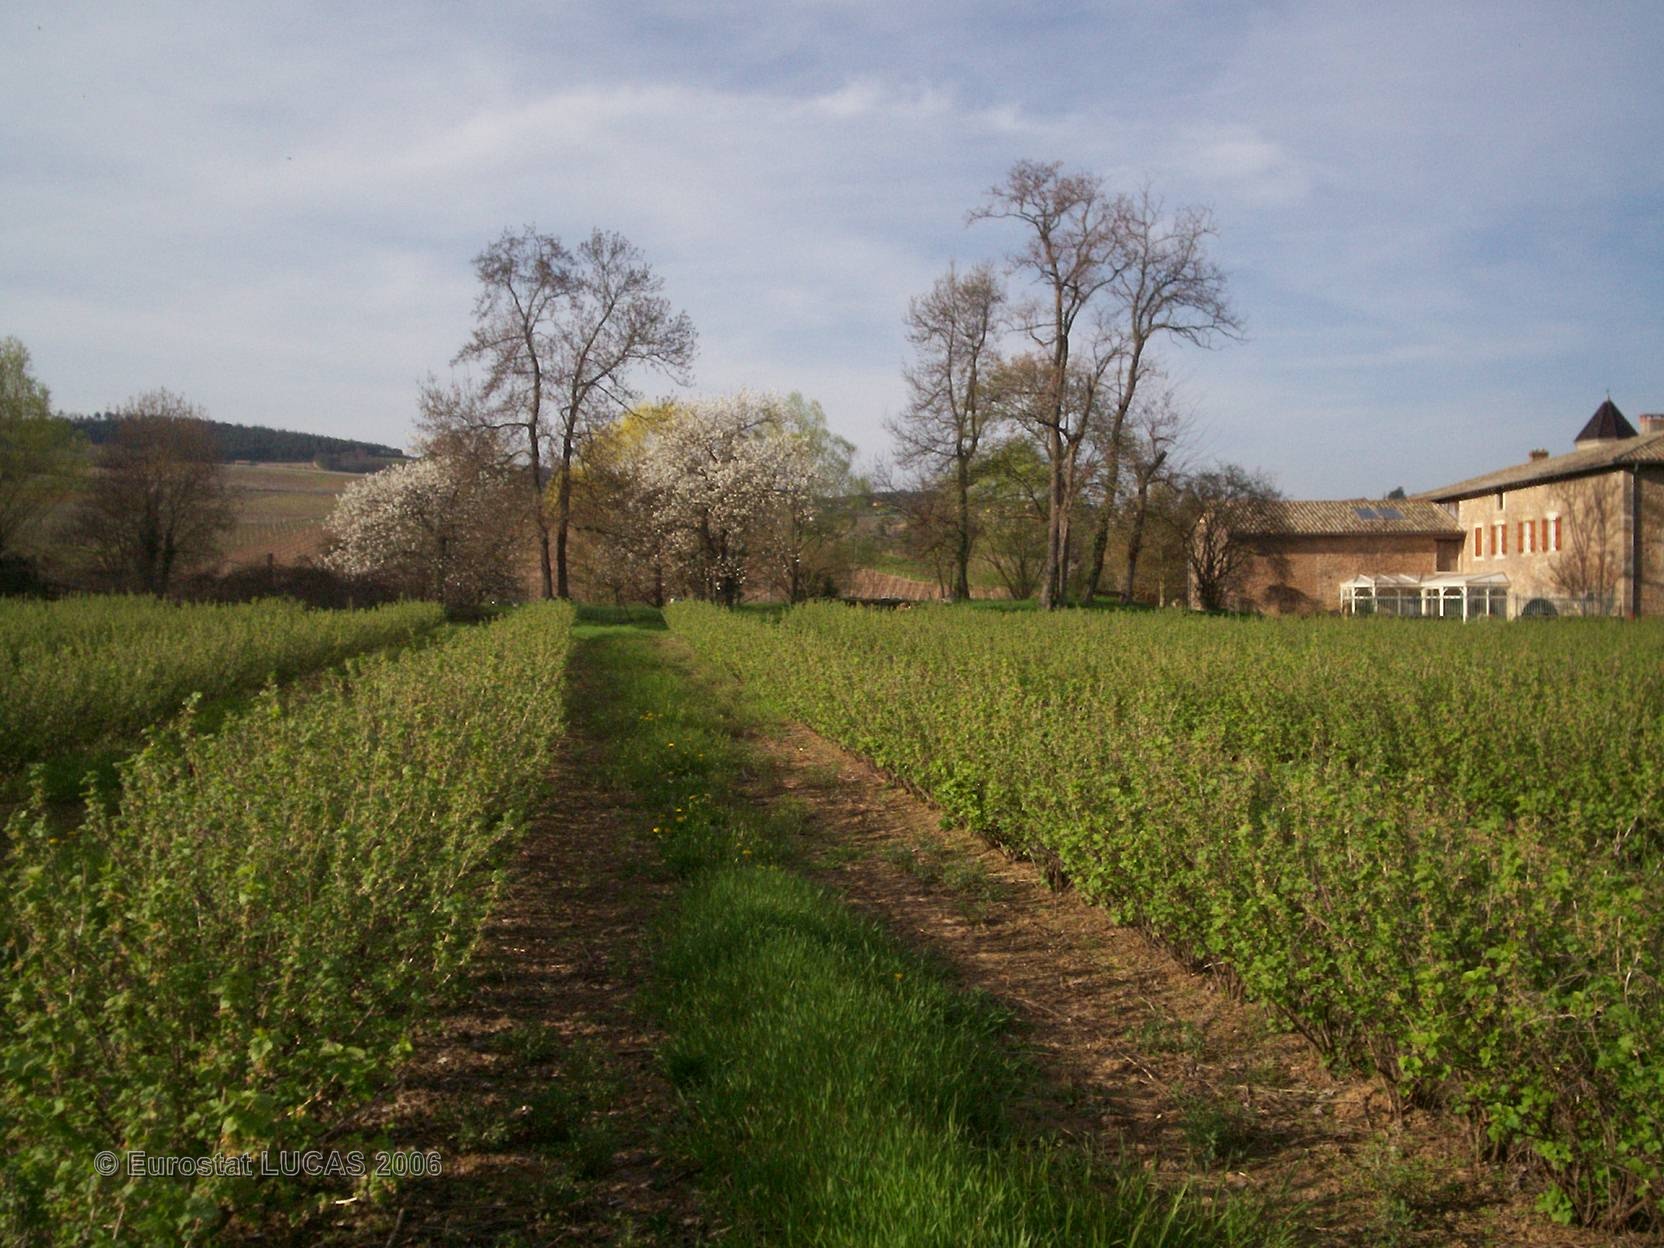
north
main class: Cropland
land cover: Other fruit trees and berries
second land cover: Grassland with sparse tree/shrub cover
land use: Agriculture (excluding fallow land and kitchen gardens)
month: April
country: FR
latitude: 46.3302
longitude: 4.7412
